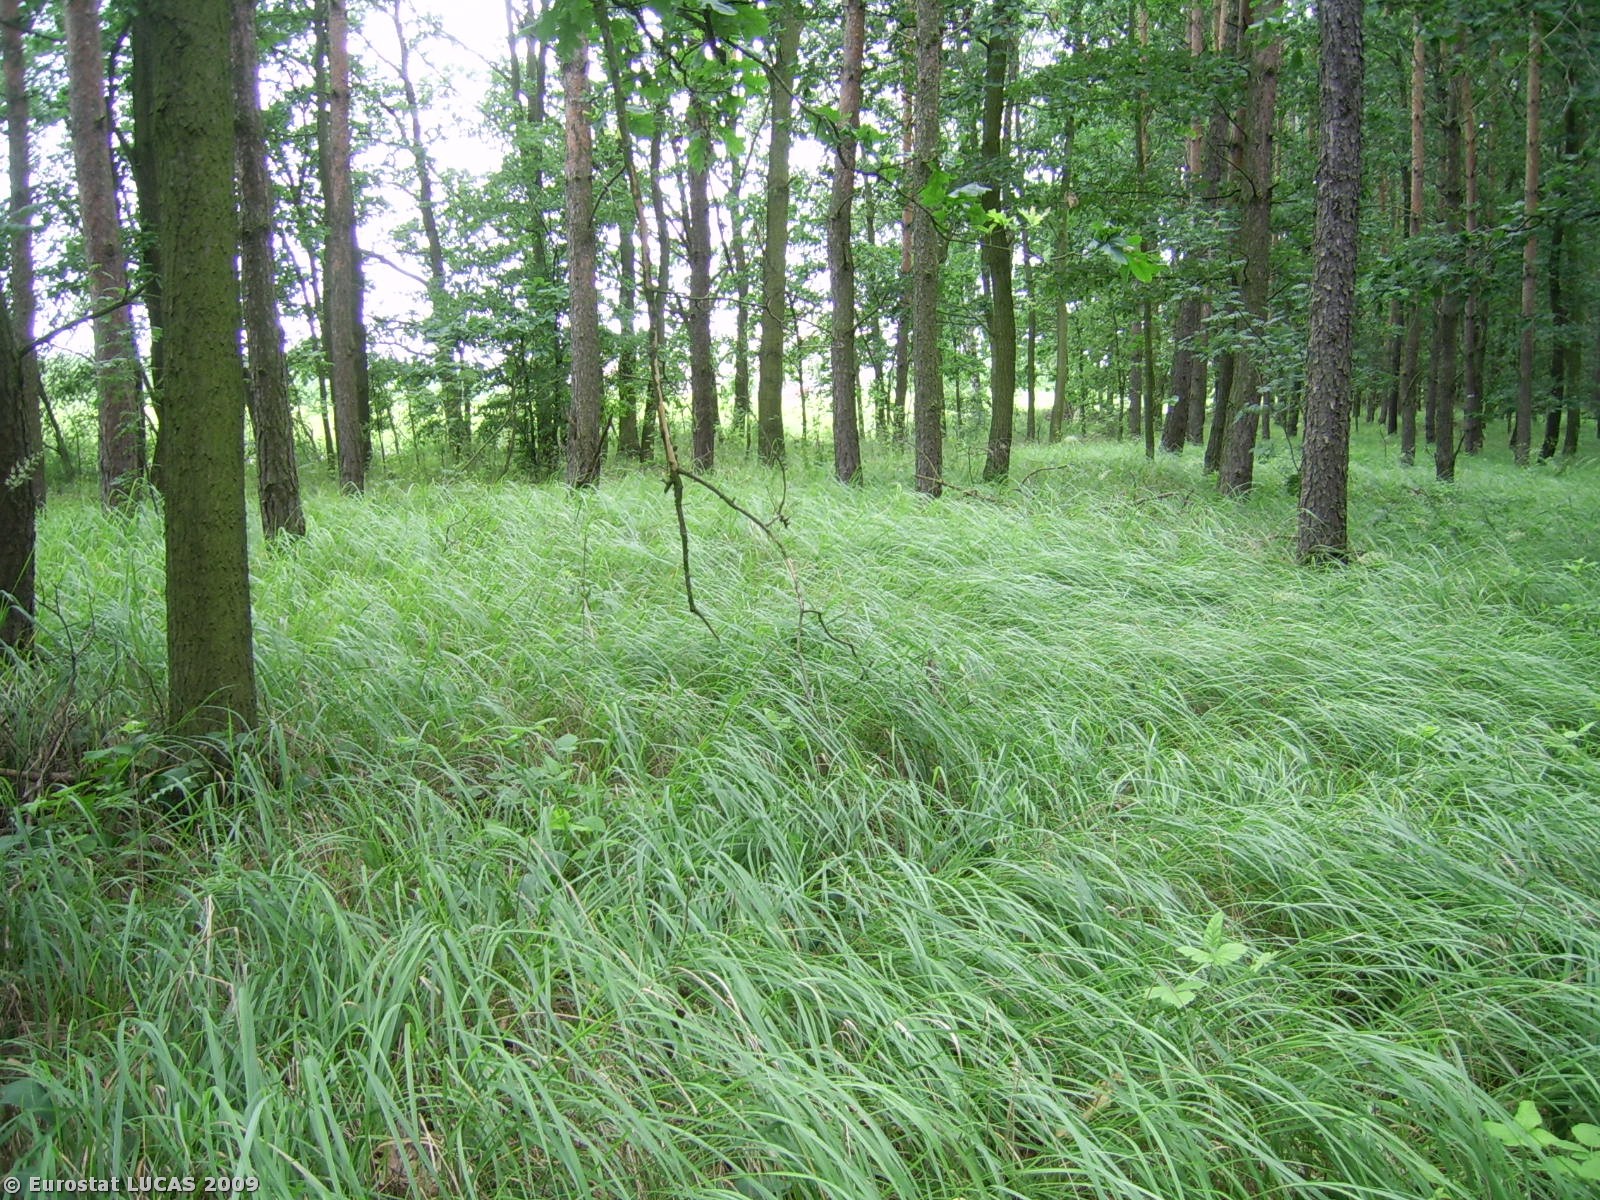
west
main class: Woodland
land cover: Mixed woodland
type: hemiboreal forest and nemoral coniferous forest and mixed broadleaved-coniferous forest
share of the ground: 50 - 75 %
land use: Unused
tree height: > 5 m
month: July
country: PL
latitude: 53.1757
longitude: 18.2305
